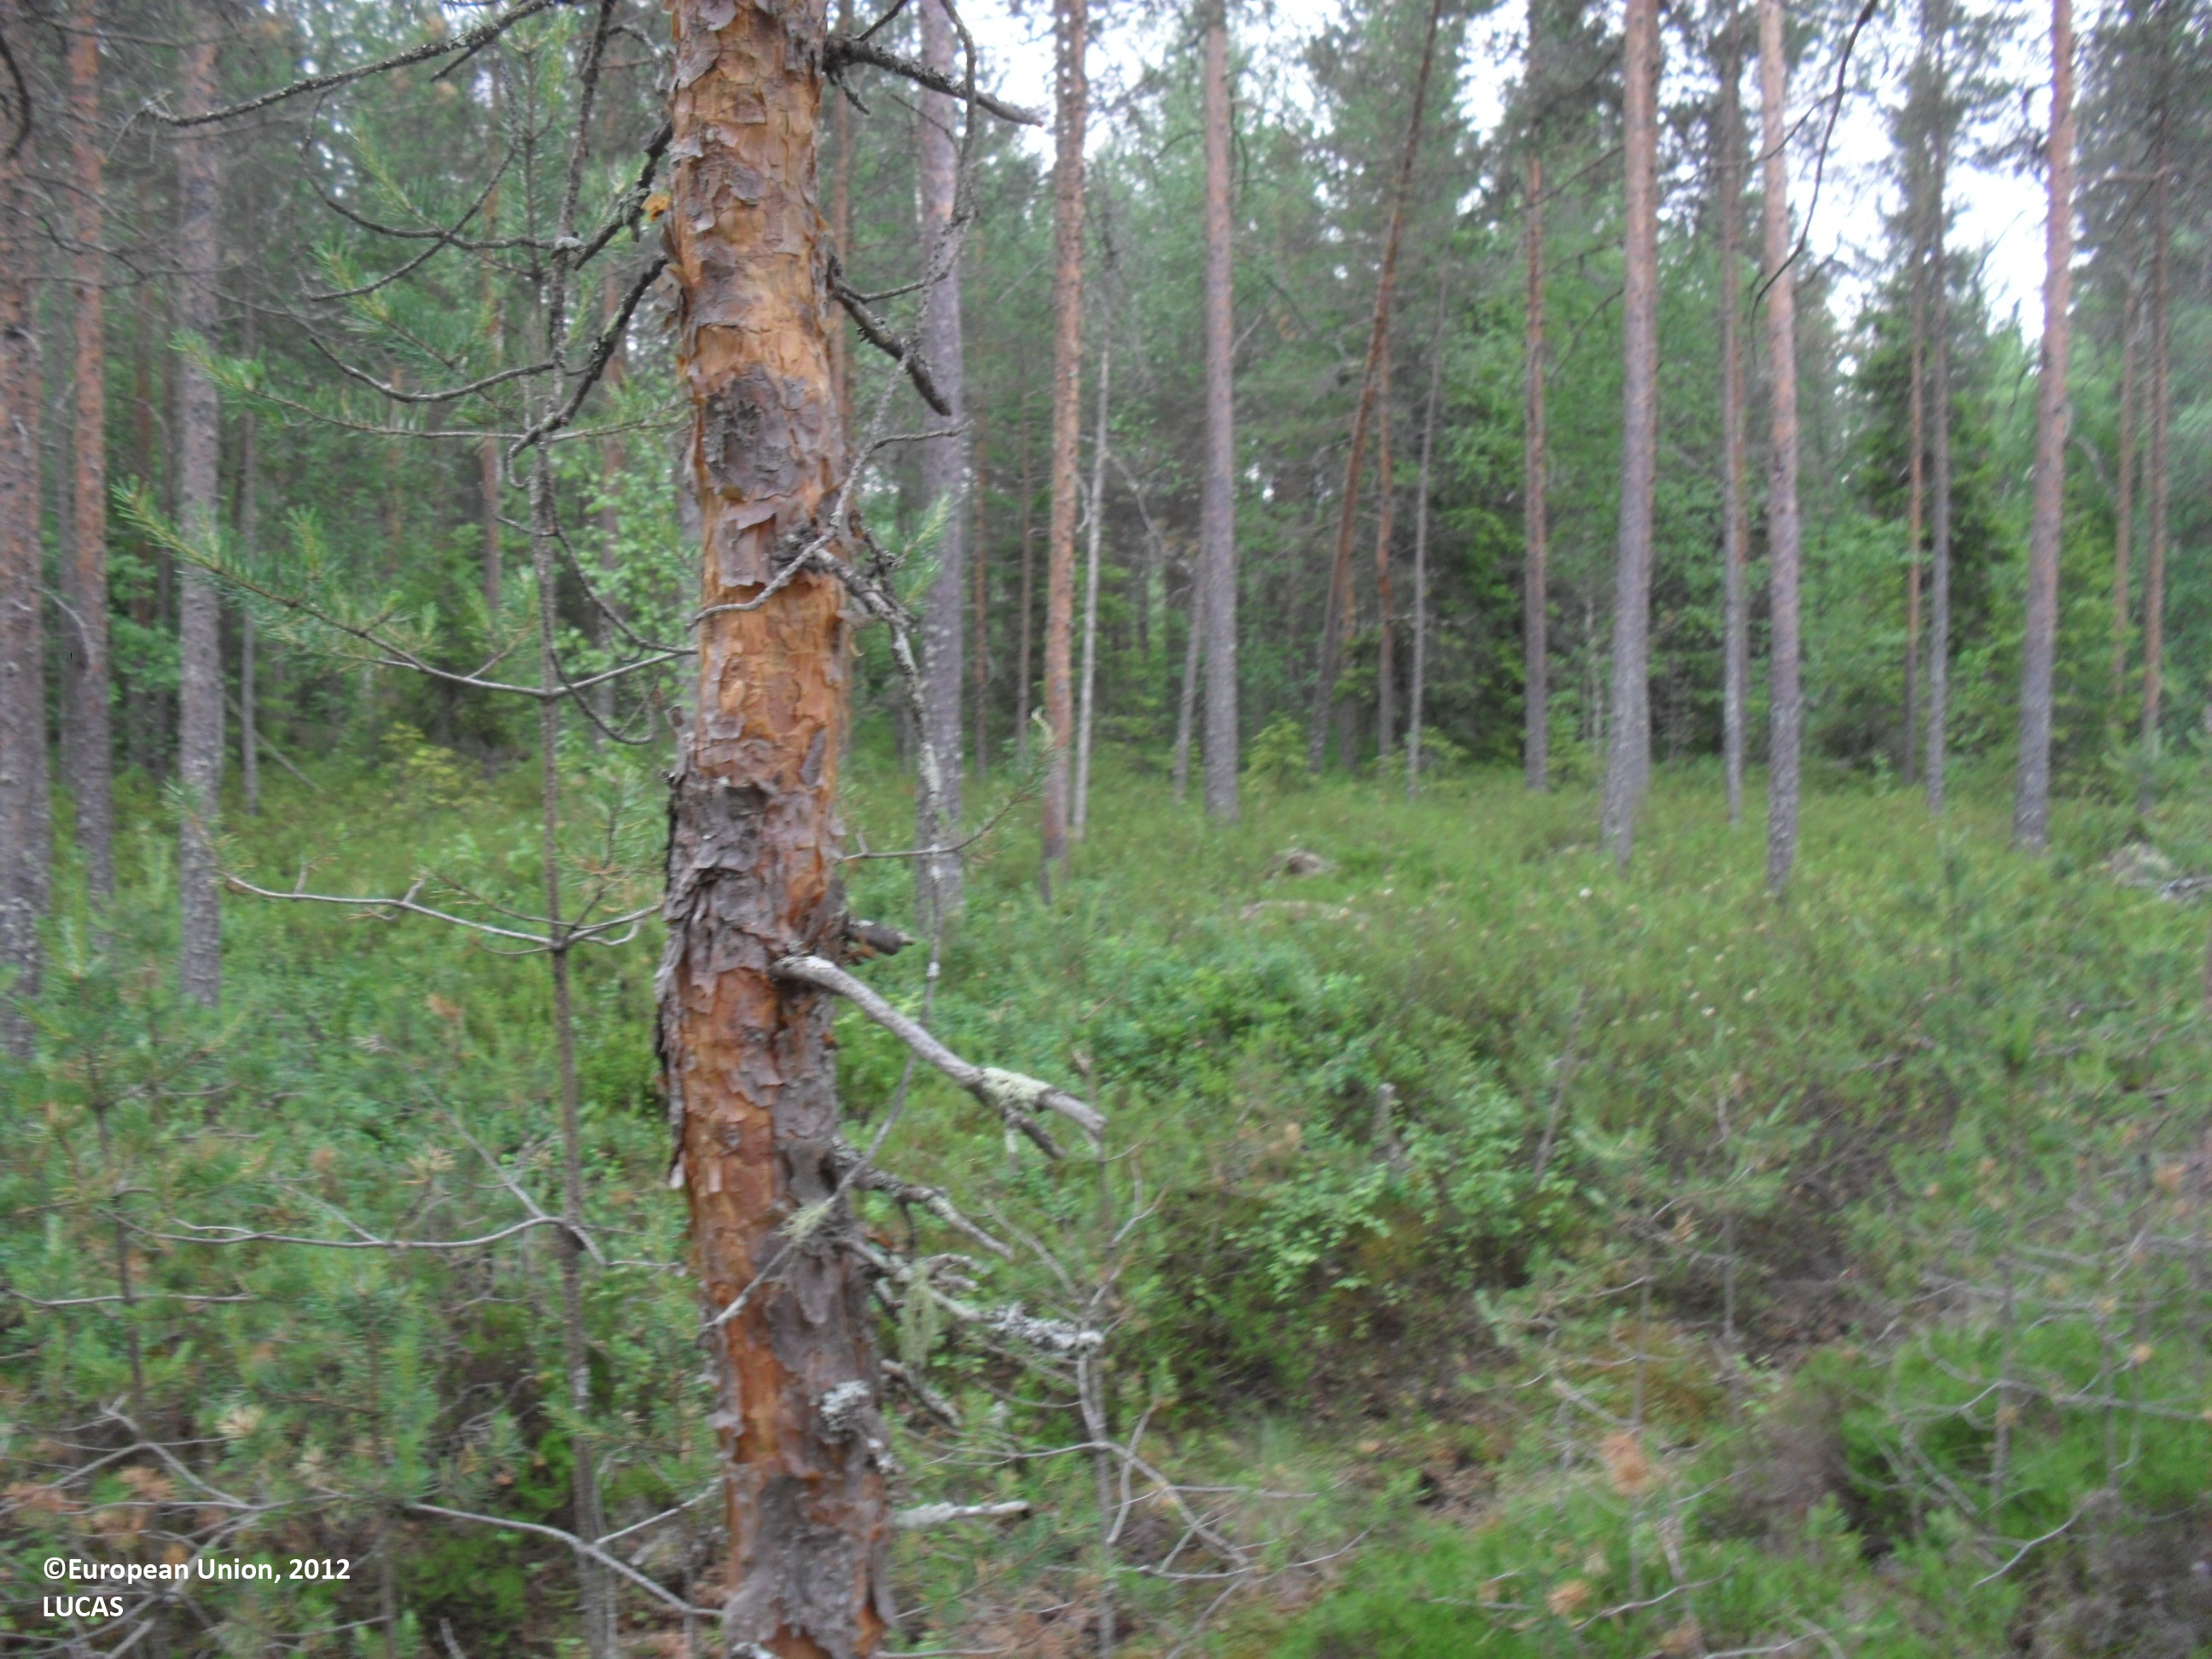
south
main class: Woodland
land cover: Pine dominated coniferous woodland
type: mire and swamp forests
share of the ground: 25 - 50 %
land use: Forestry
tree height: > 5 m
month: July
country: FI
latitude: 63.5760
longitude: 23.5363
